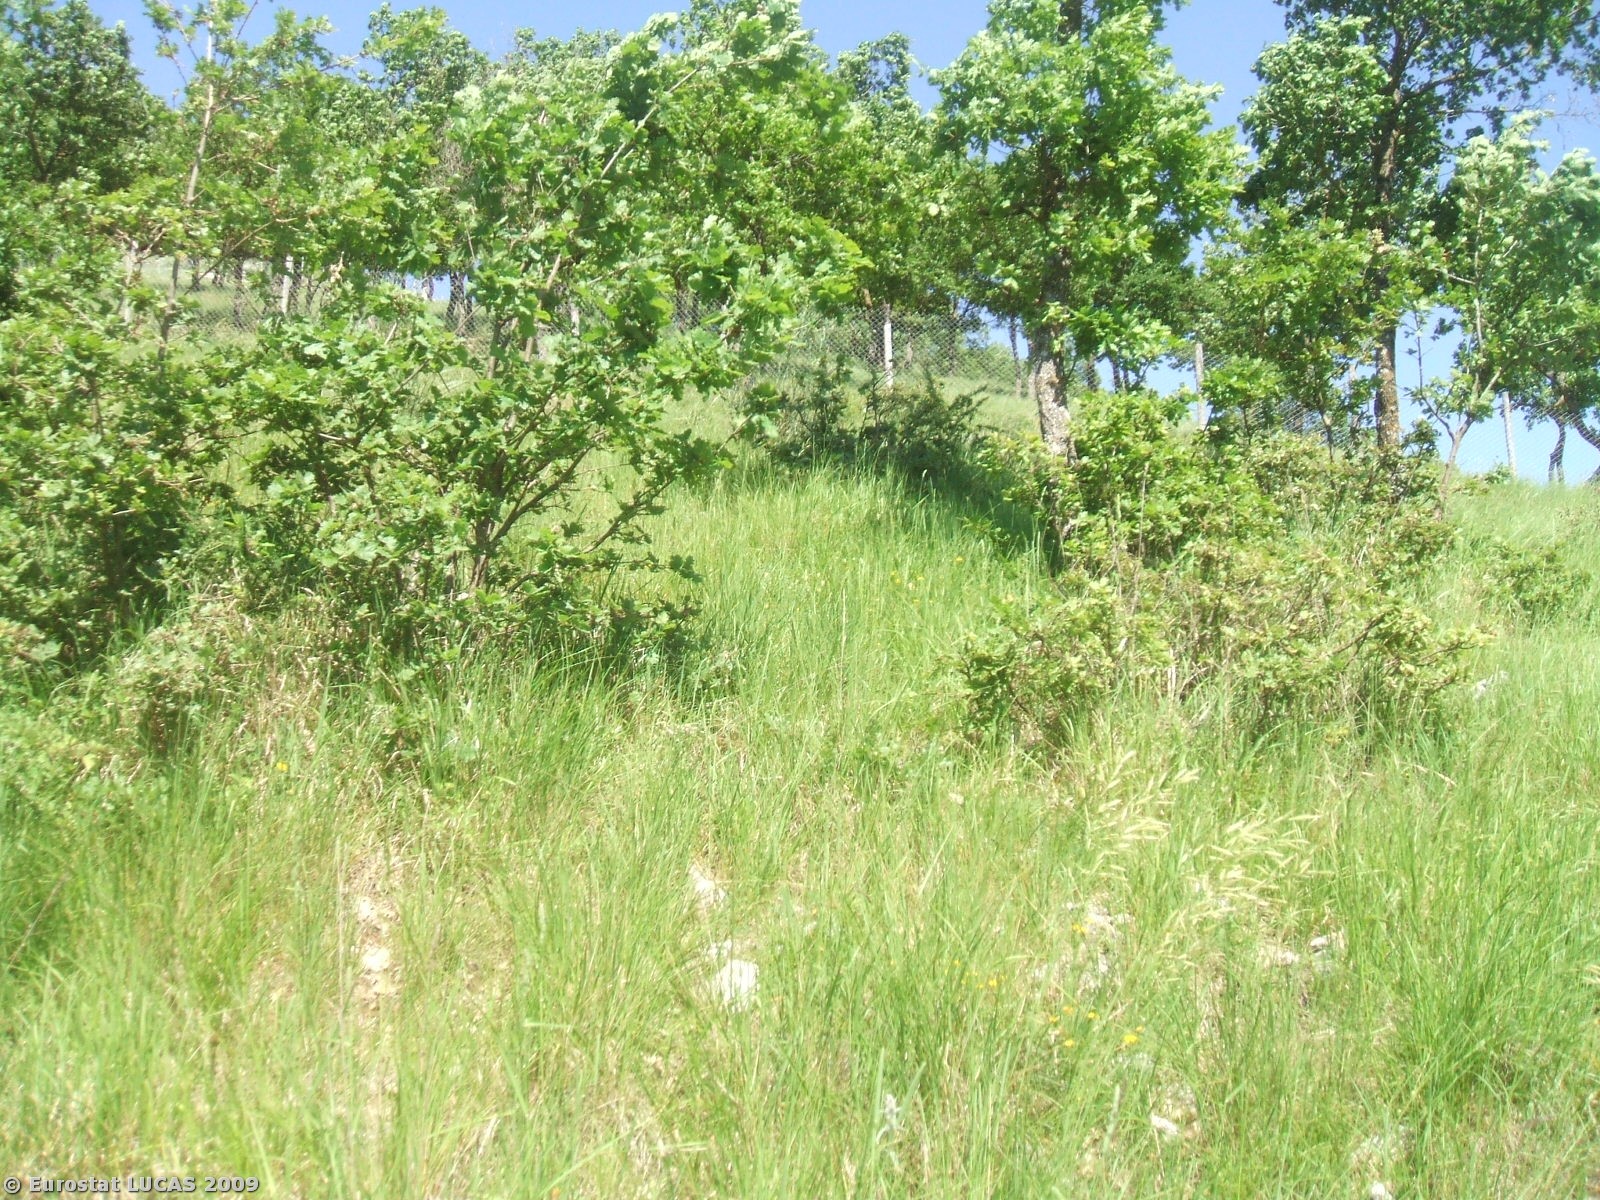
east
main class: Woodland
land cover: Broadleaved woodland
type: mesophytic deciduous forest
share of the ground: > 75 %
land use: Forestry
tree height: > 5 m
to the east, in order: Broadleaved woodland; Fences; Broadleaved woodland; Electric lines; Broadleaved woodland; Grassland with sparse tree/shrub cover; Fences; Grassland with sparse tree/shrub cover
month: May
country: IT
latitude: 40.3133
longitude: 15.8008
